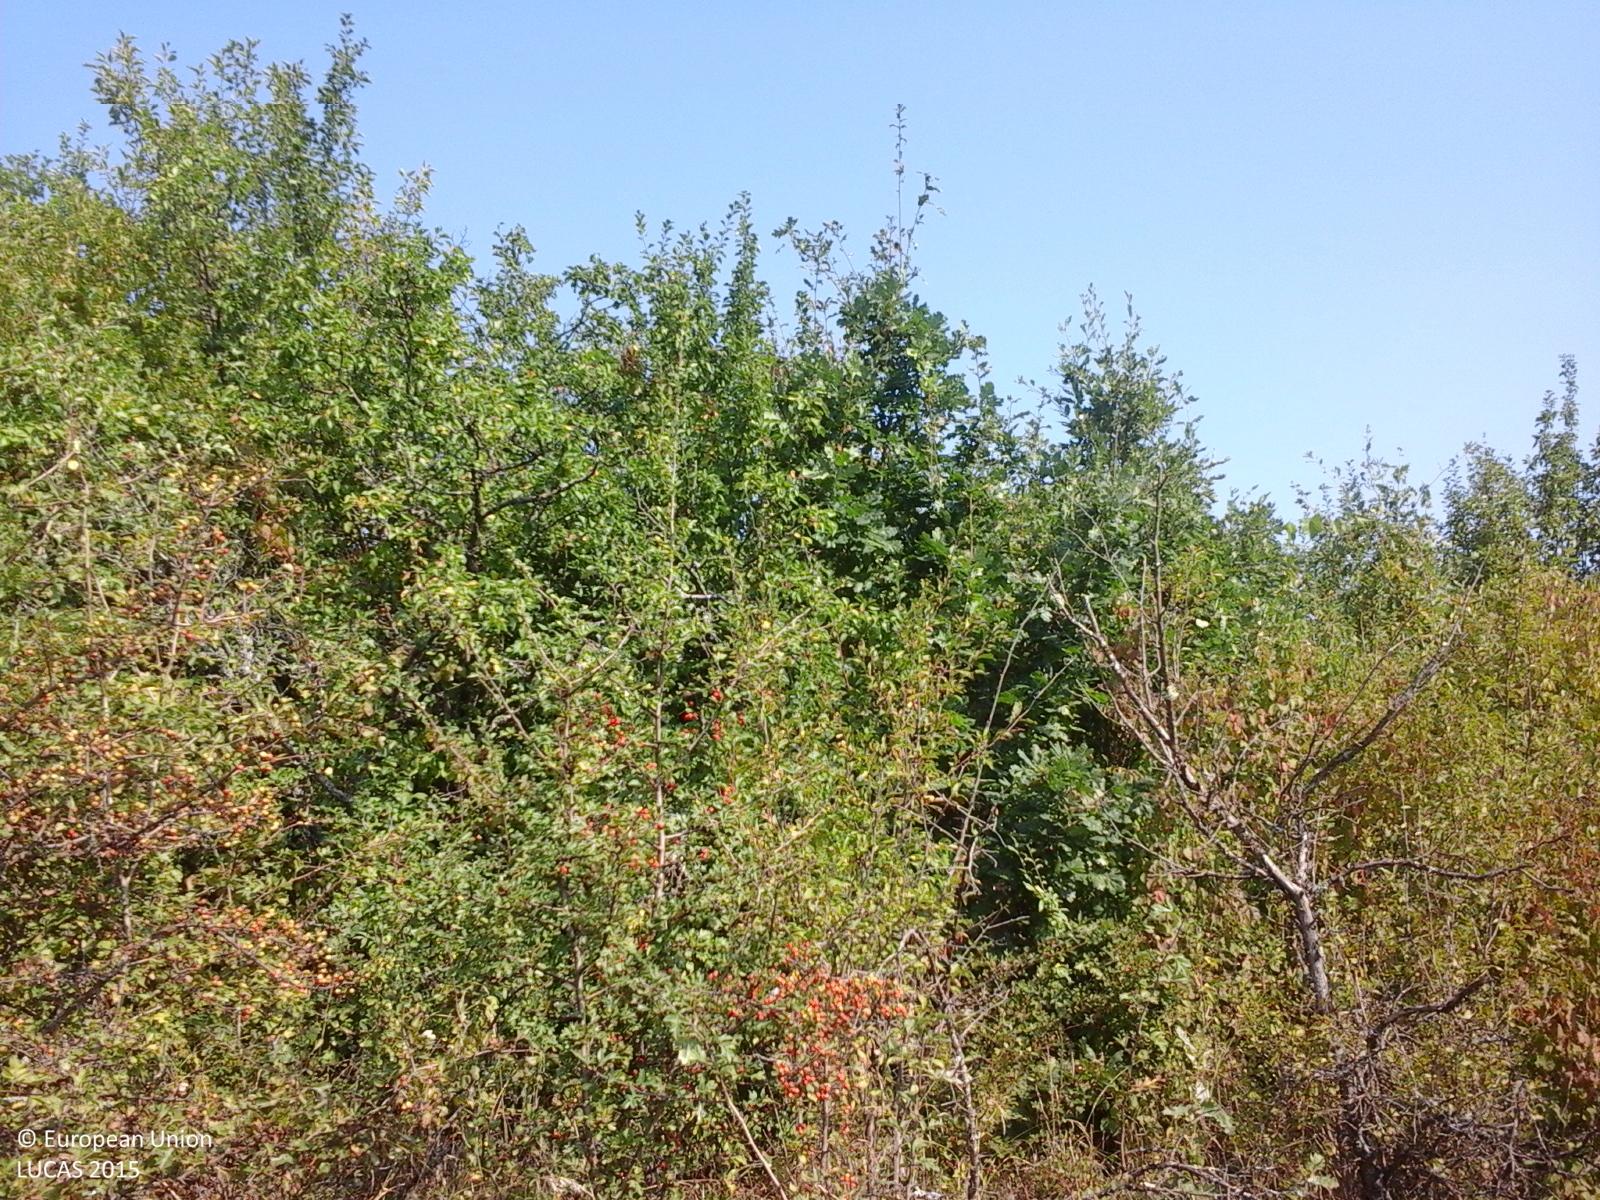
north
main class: Shrubland
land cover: Shrubland with sparse tree cover
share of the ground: > 75 %
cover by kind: shrubs 95 %, broadleaved forest trees 5 %
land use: Semi-natural and natural areas not in use
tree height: < 5 m
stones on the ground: < 10 %
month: September
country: RO
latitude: 47.0036
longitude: 24.4915
